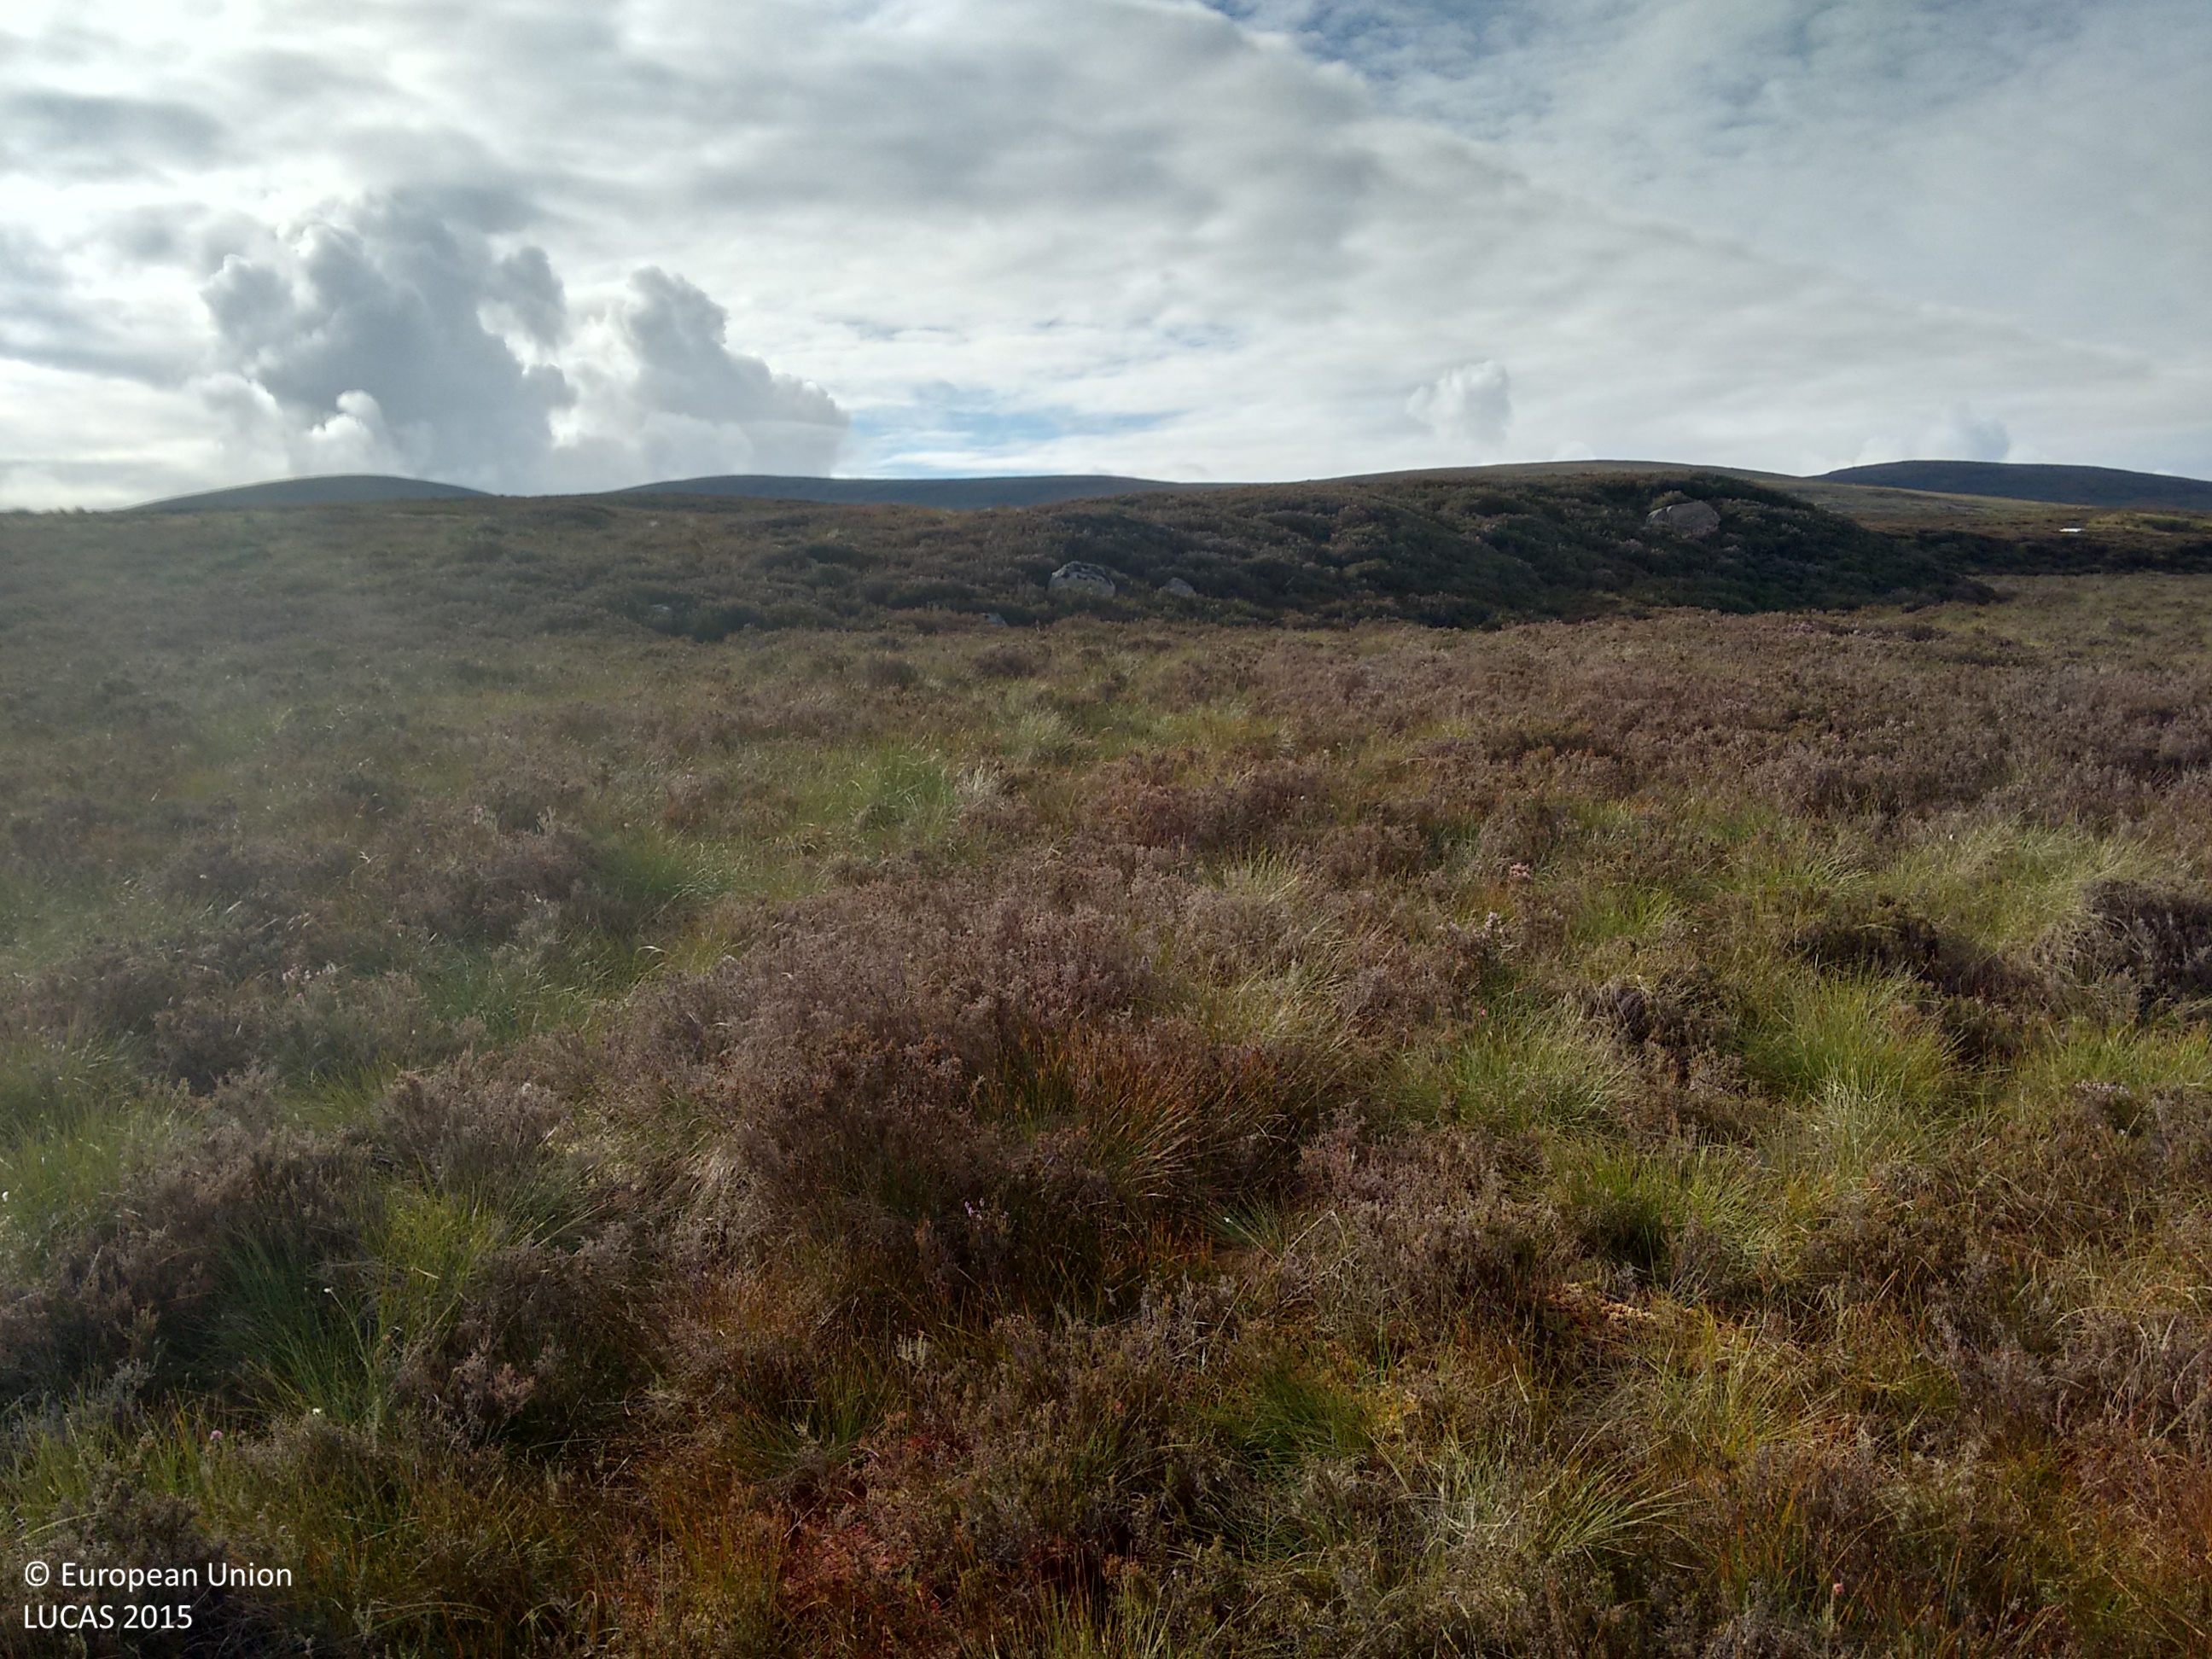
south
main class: Shrubland
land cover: Shrubland without tree cover
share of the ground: > 75 %
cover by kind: shrubs 75 %, herbaceous plants 20 %, lichens and mosses 5 %
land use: Semi-natural and natural areas not in use
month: September
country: GB
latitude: 57.8461
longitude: -4.3553
